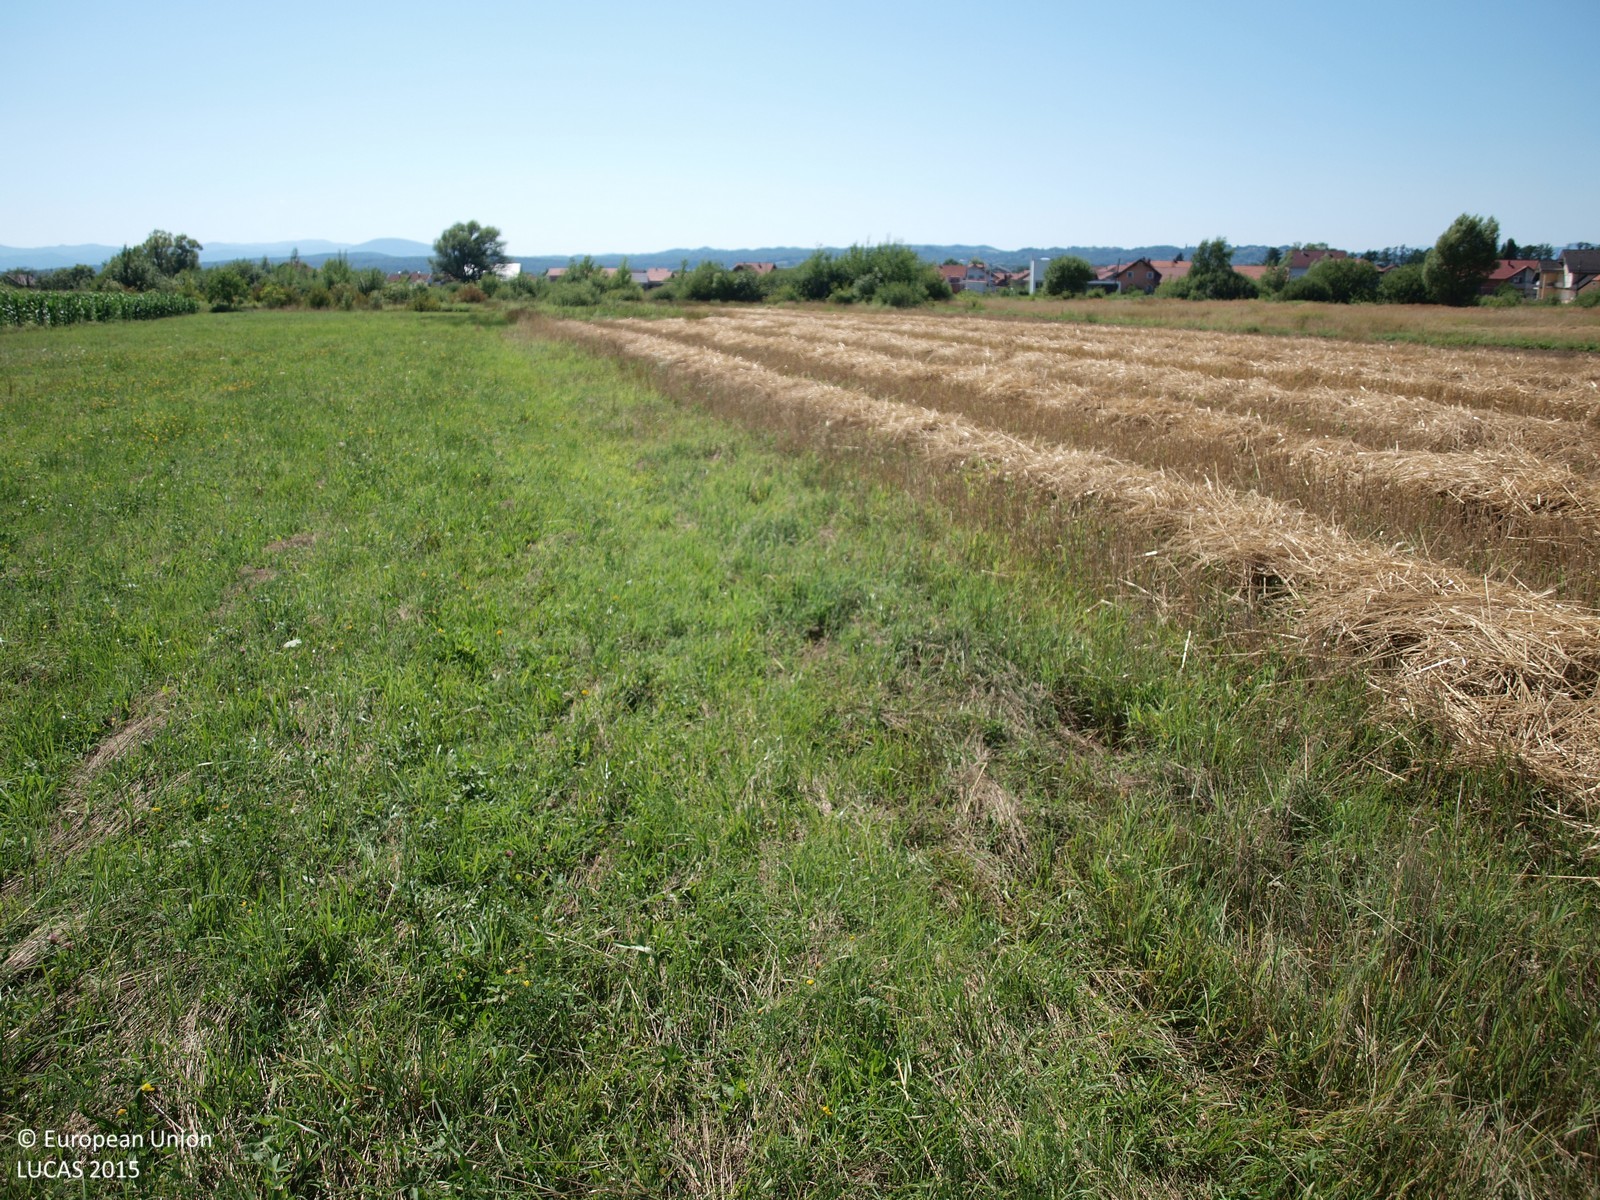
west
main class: Grassland
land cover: Grassland without tree/shrub cover
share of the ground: > 75 %
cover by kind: herbaceous plants 100 %
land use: Agriculture (excluding fallow land and kitchen gardens)
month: July
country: HR
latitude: 45.9015
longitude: 15.8626
